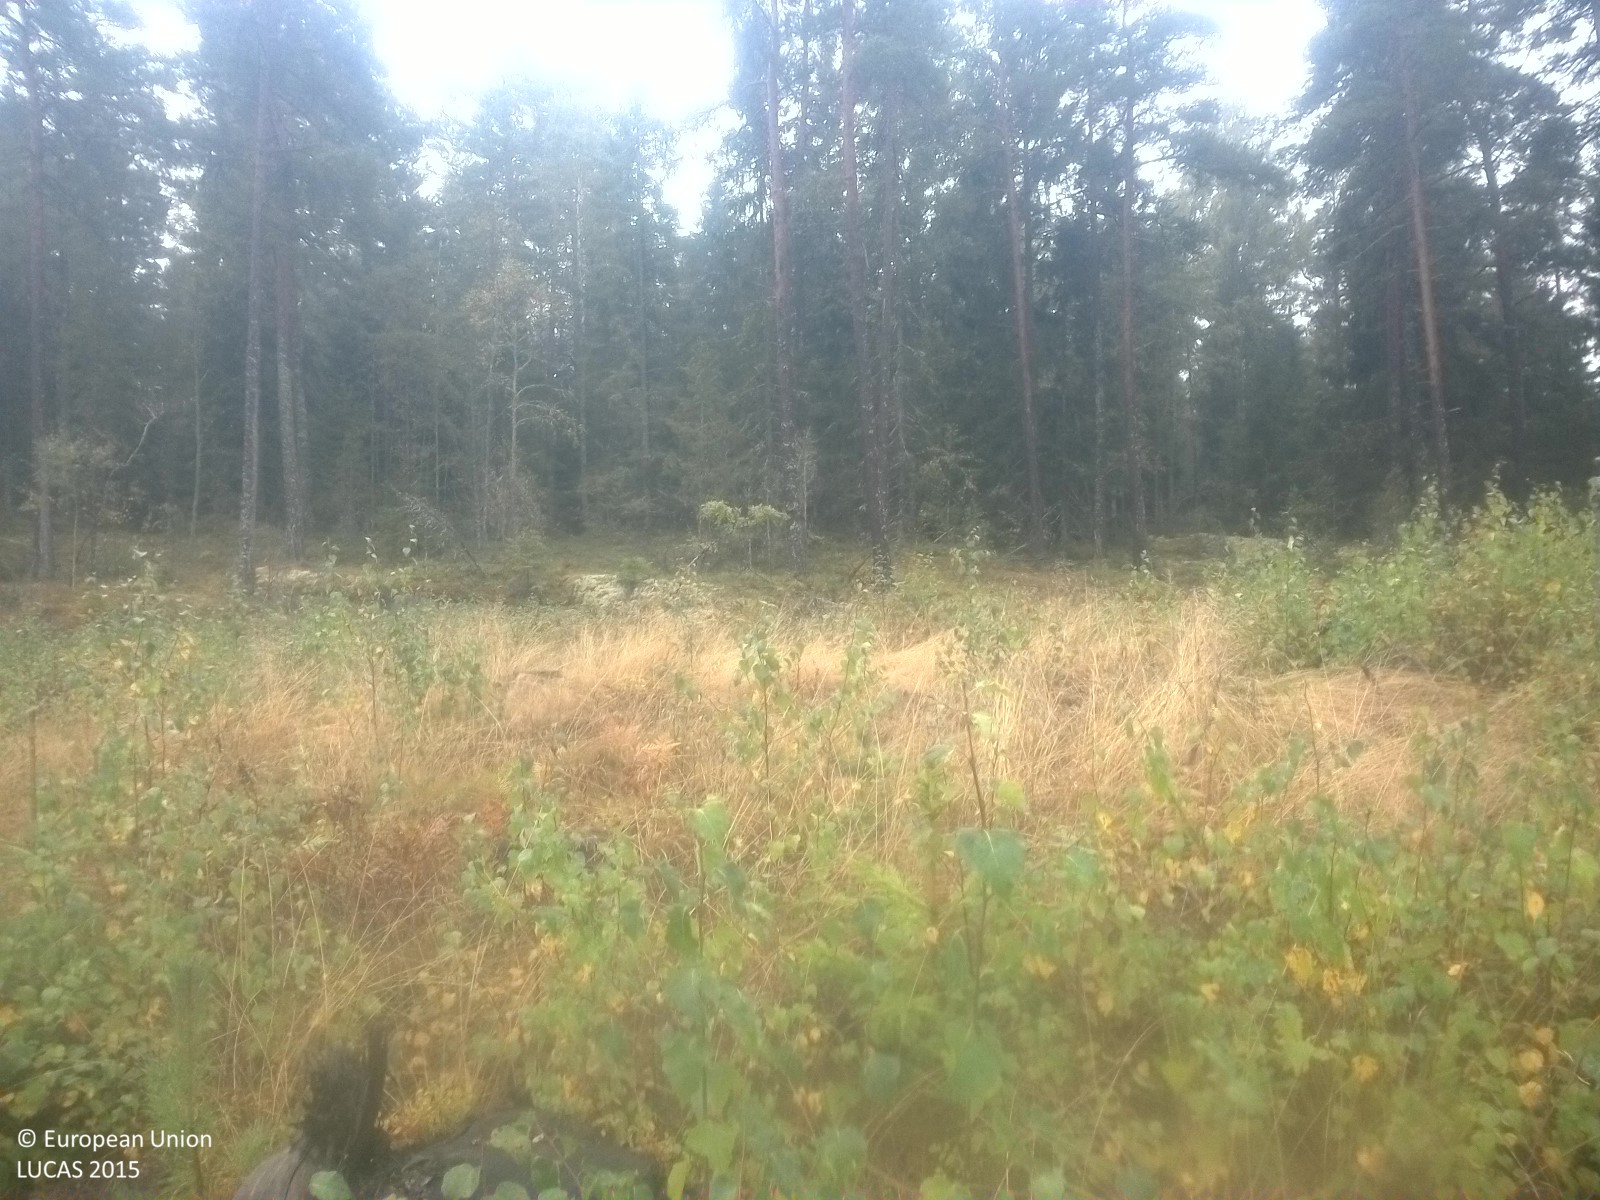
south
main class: Woodland
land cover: Broadleaved woodland
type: boreal forest
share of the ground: 50 - 75 %
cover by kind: broadleaved forest trees 55 %, herbaceous plants 35 %, coniferous forest trees 5 %, lichens and mosses 5 %
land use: Forestry
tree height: < 5 m
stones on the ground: 10 - 25 %
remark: Clear cut
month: September
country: SE
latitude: 58.5197
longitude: 16.7441
